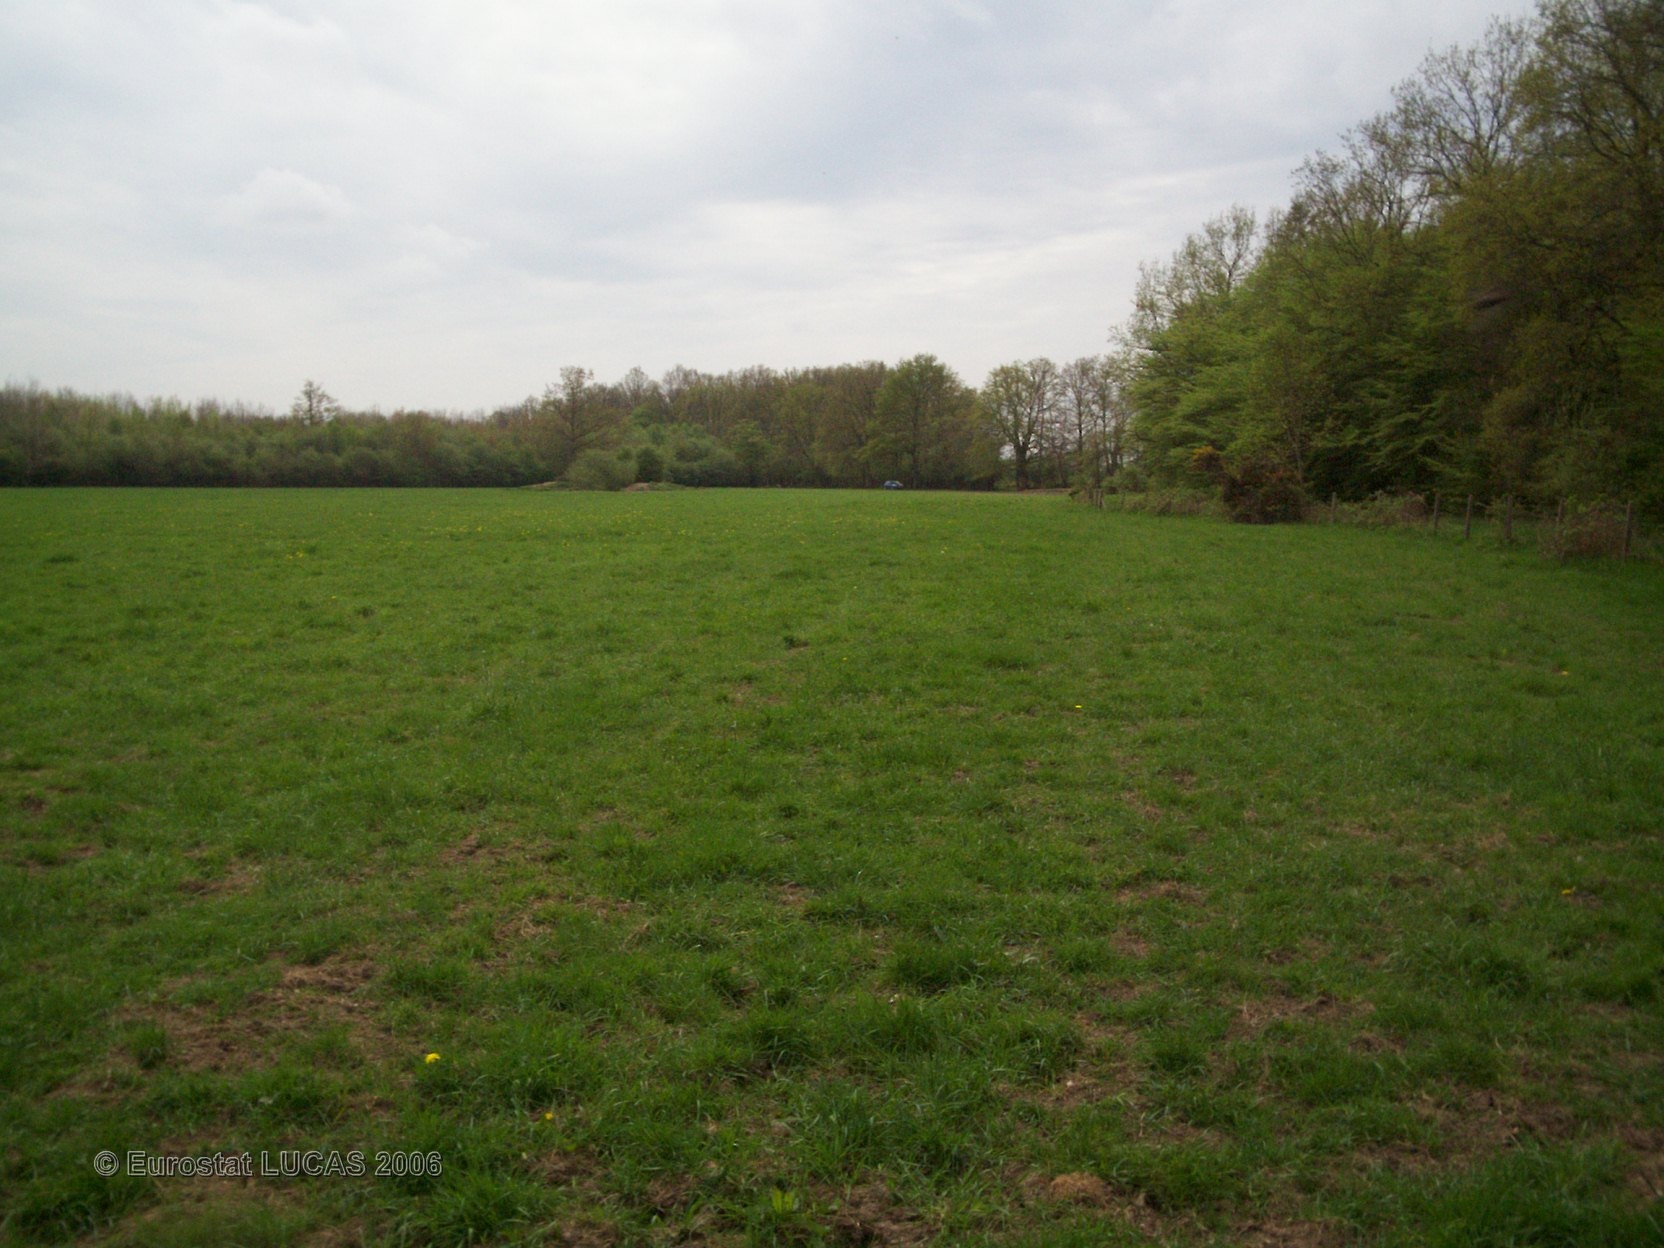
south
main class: Grassland
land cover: Grassland without tree/shrub cover
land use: Agriculture (excluding fallow land and kitchen gardens)
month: May
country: FR
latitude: 48.9034
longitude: 0.5478
